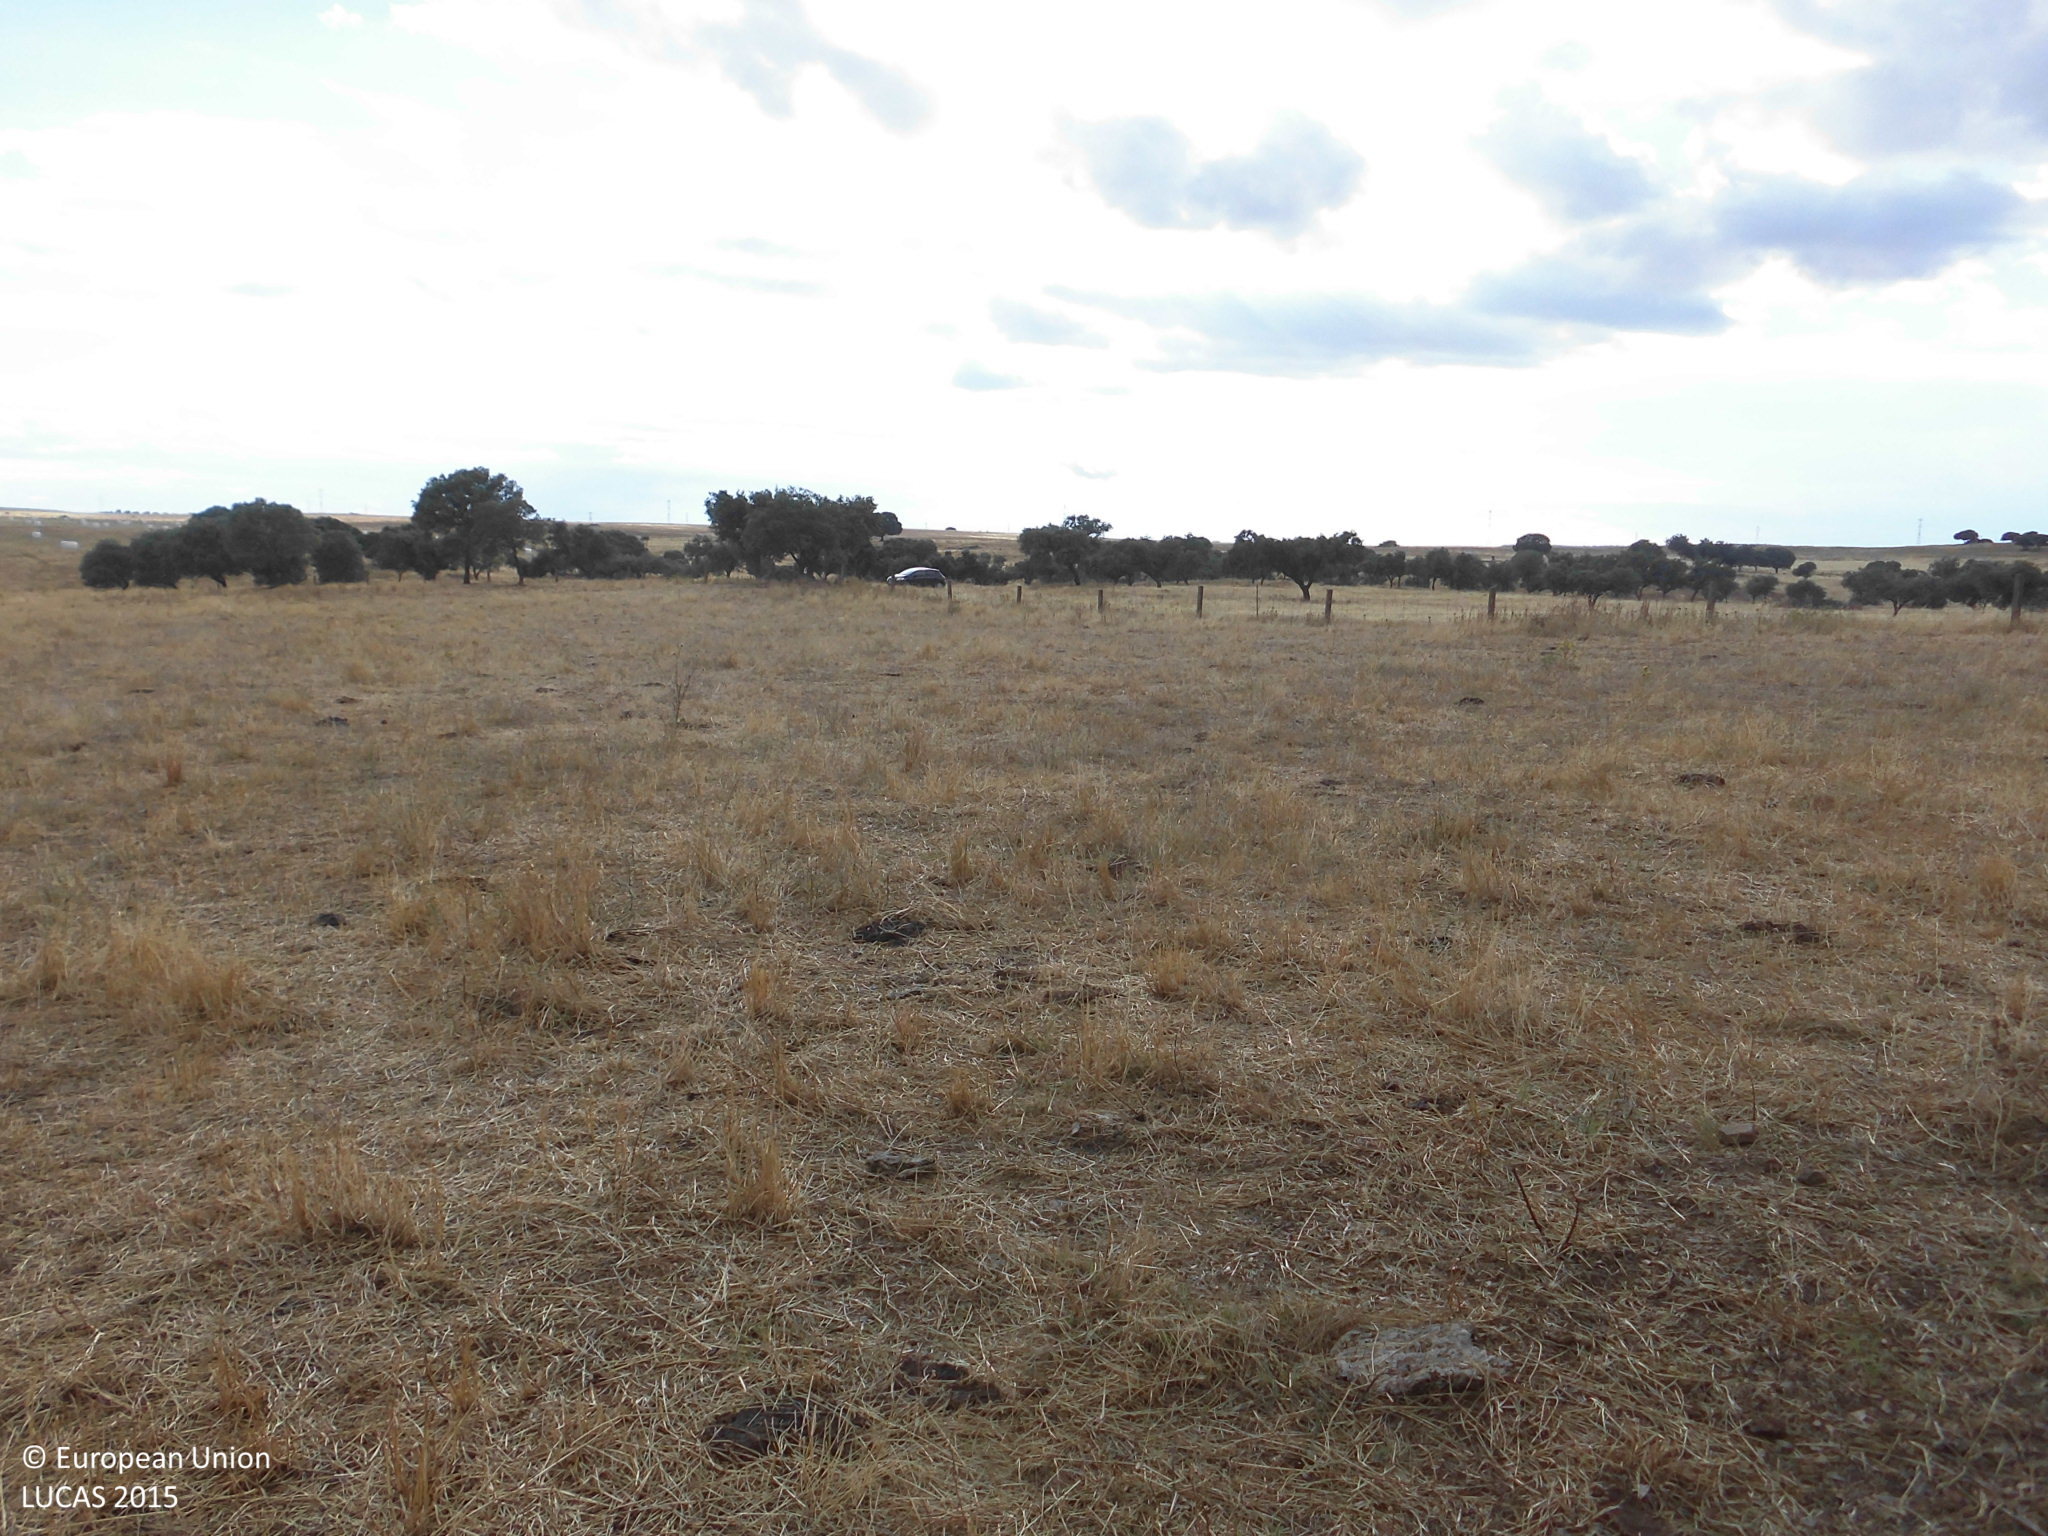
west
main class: Grassland
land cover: Grassland with sparse tree/shrub cover
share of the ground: > 75 %
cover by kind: herbaceous plants 95 %, broadleaved forest trees 5 %
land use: Agriculture (excluding fallow land and kitchen gardens)
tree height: > 5 m
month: June
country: ES
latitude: 39.3372
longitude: -5.9639
